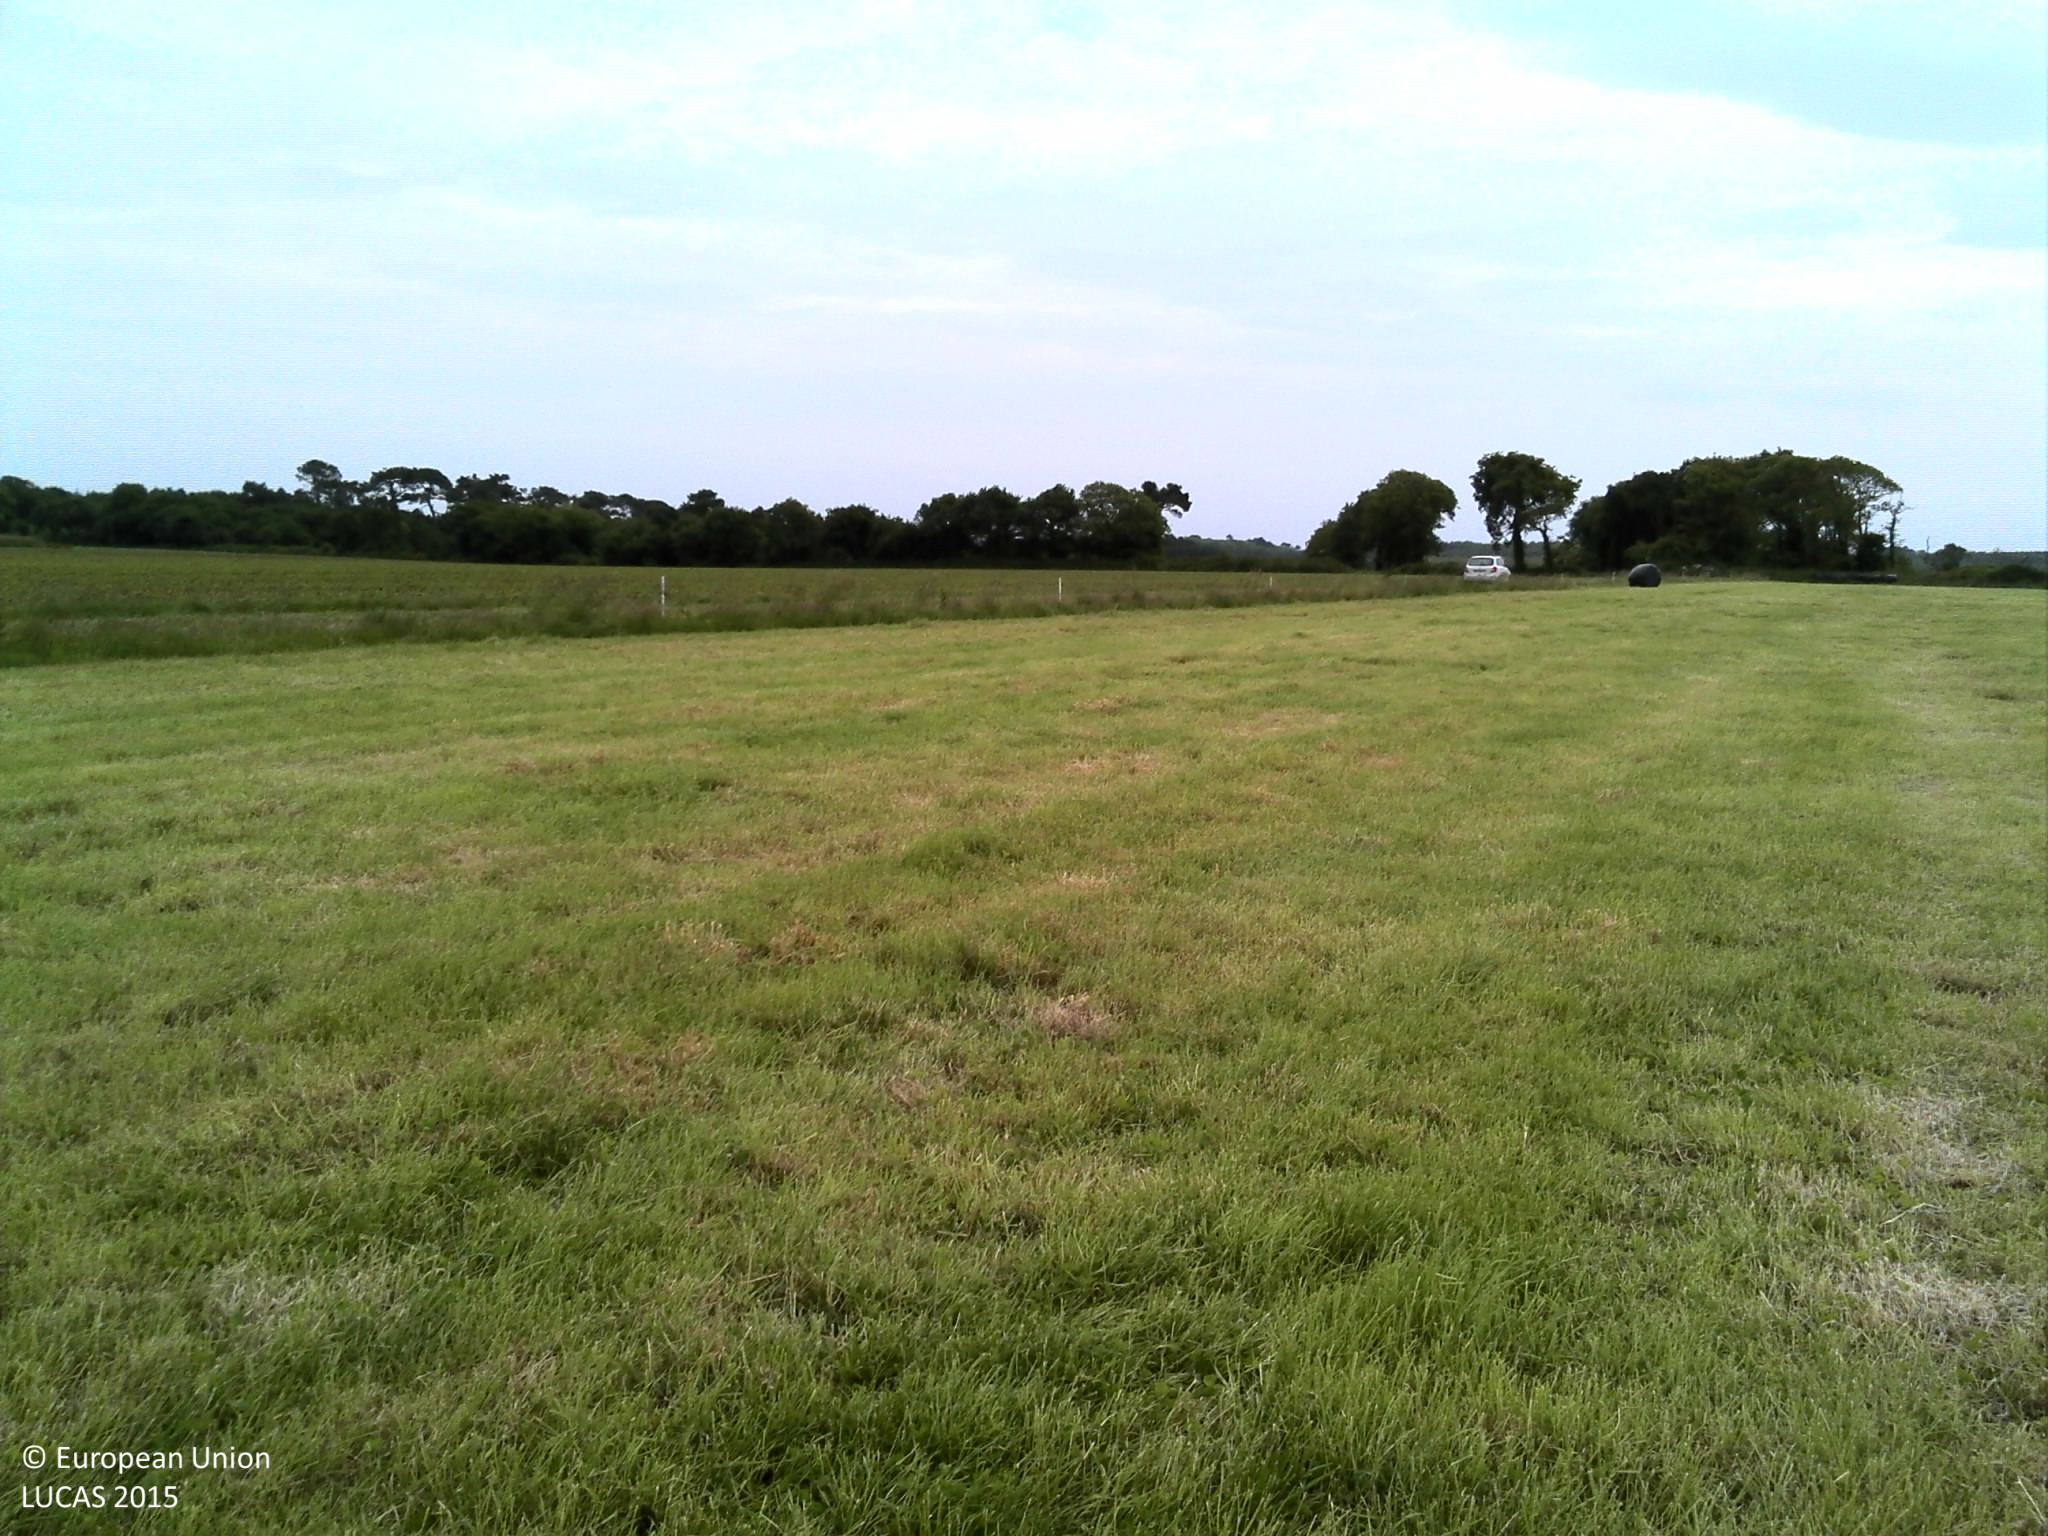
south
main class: Cropland
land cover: Temporary grasslands
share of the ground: > 75 %
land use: Agriculture (excluding fallow land and kitchen gardens)
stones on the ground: < 10 %
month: June
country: FR
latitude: 48.0069
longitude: -4.3694
